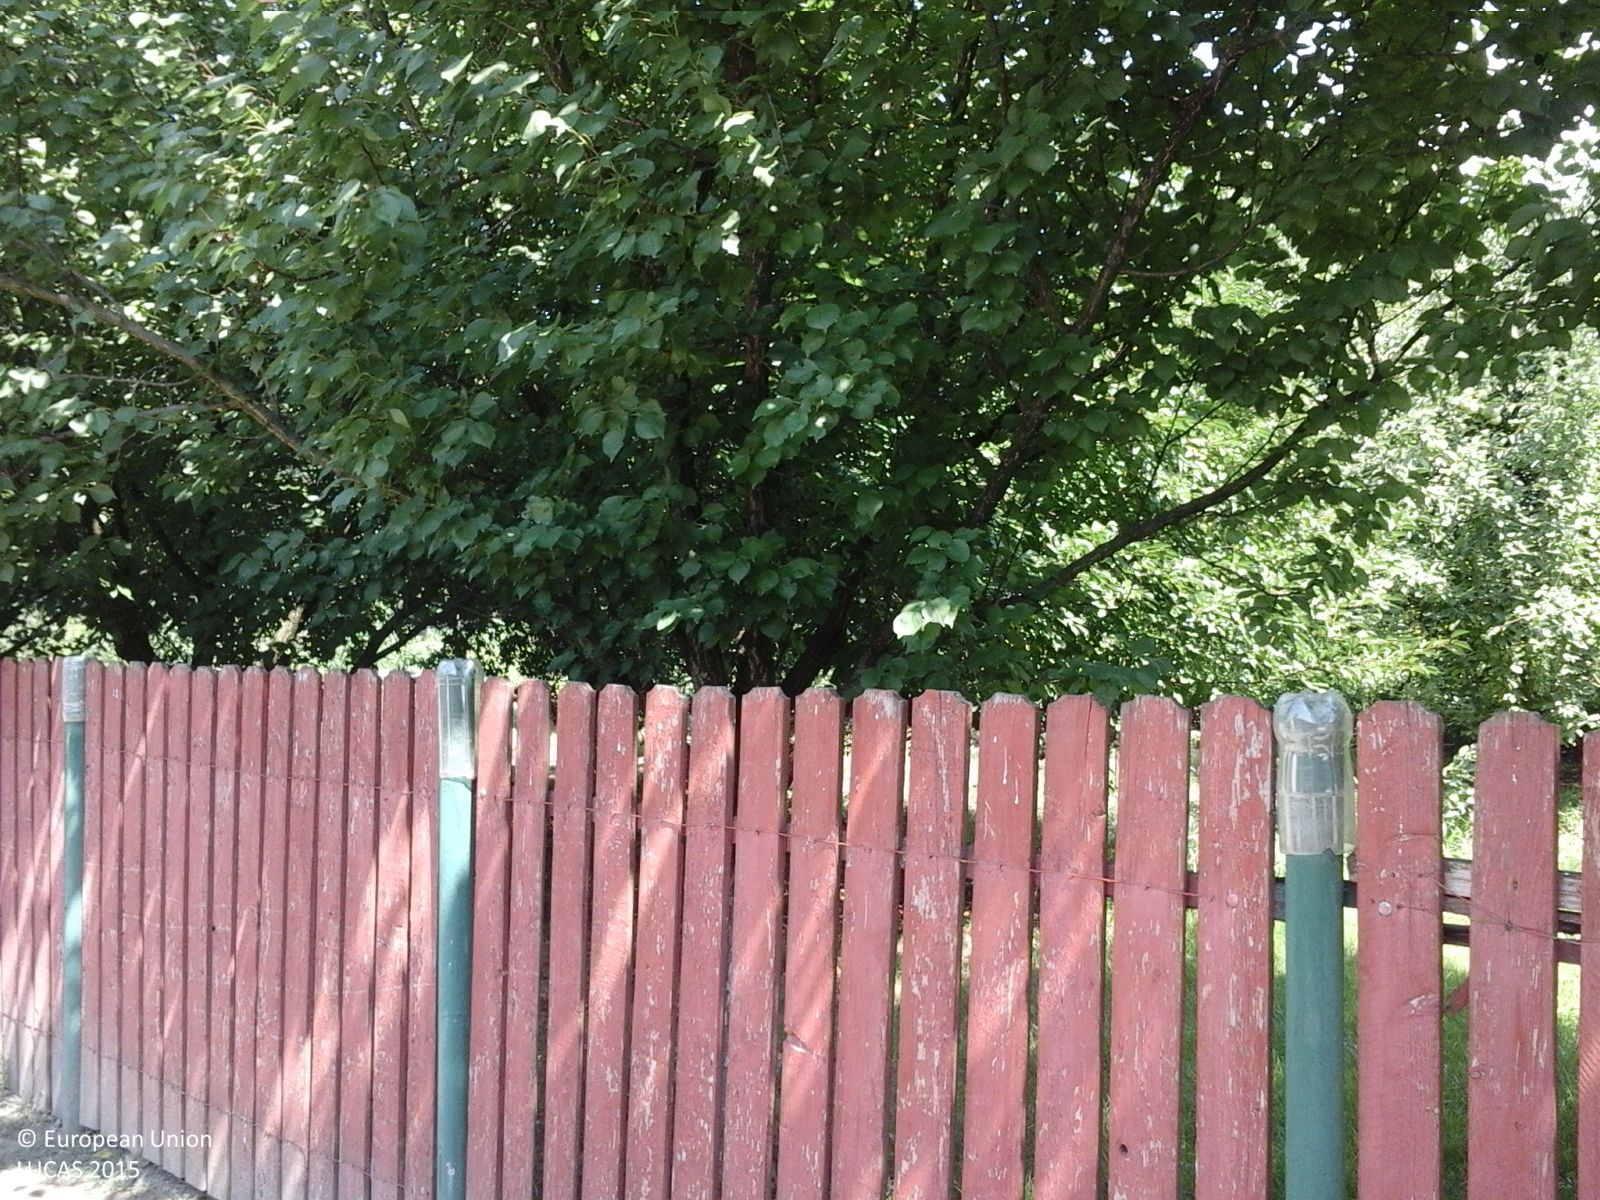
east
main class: Cropland
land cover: Apple fruit
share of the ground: 50 - 75 %
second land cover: Grassland without tree/shrub cover
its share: > 75 %
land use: Agriculture (excluding fallow land and kitchen gardens)
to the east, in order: Apple fruit; Grassland without tree/shrub cover; Fences; Arable land (only in case pi); Fences; Tracks; Fences; Lucerne; Fences; Lines of trees; Arable land (only in case pi); Artificial constructions in urban areas; Vineyards; Artificial constructions in urban areas; Arable land (only in case pi)
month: July
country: RO
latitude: 43.8976
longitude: 25.9439
